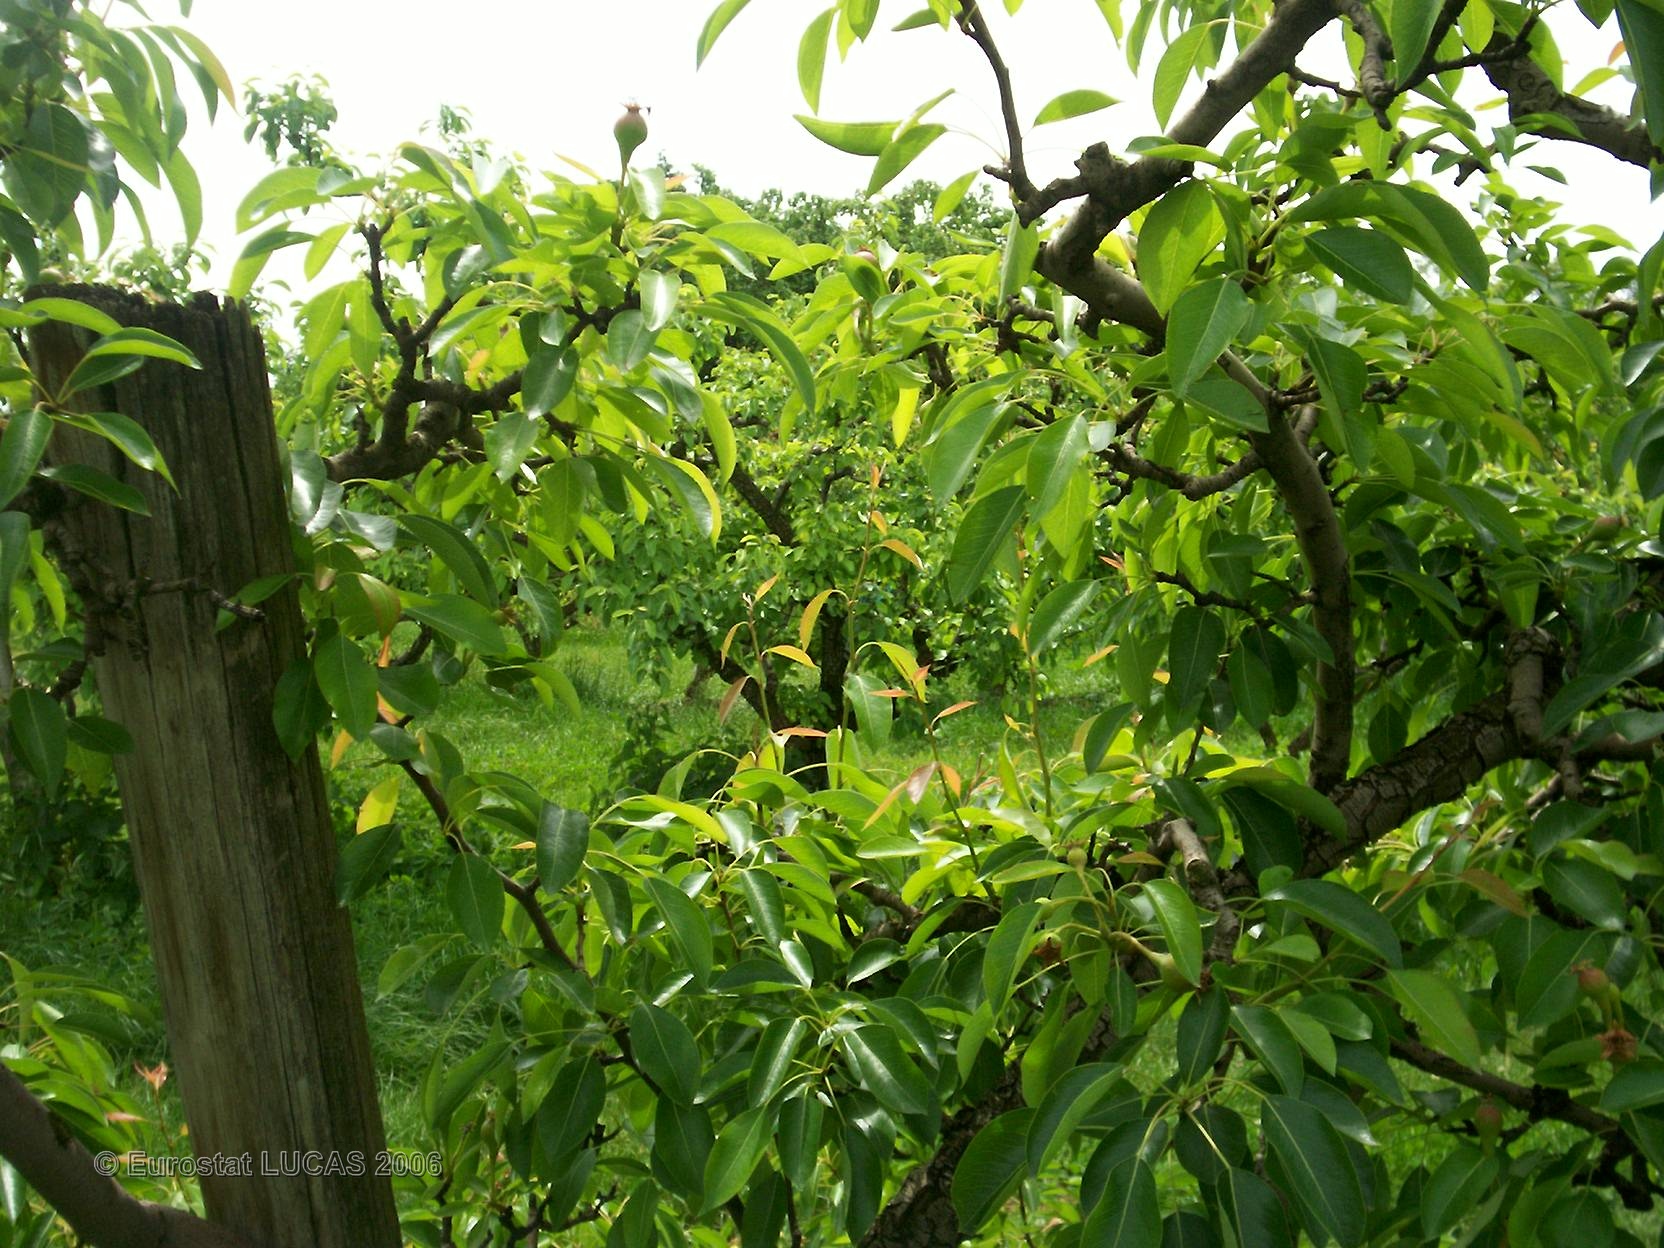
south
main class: Cropland
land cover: Pear fruit
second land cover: Grassland with sparse tree/shrub cover
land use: Agriculture (excluding fallow land and kitchen gardens)
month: May
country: FR
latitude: 45.6654
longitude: 4.8055
